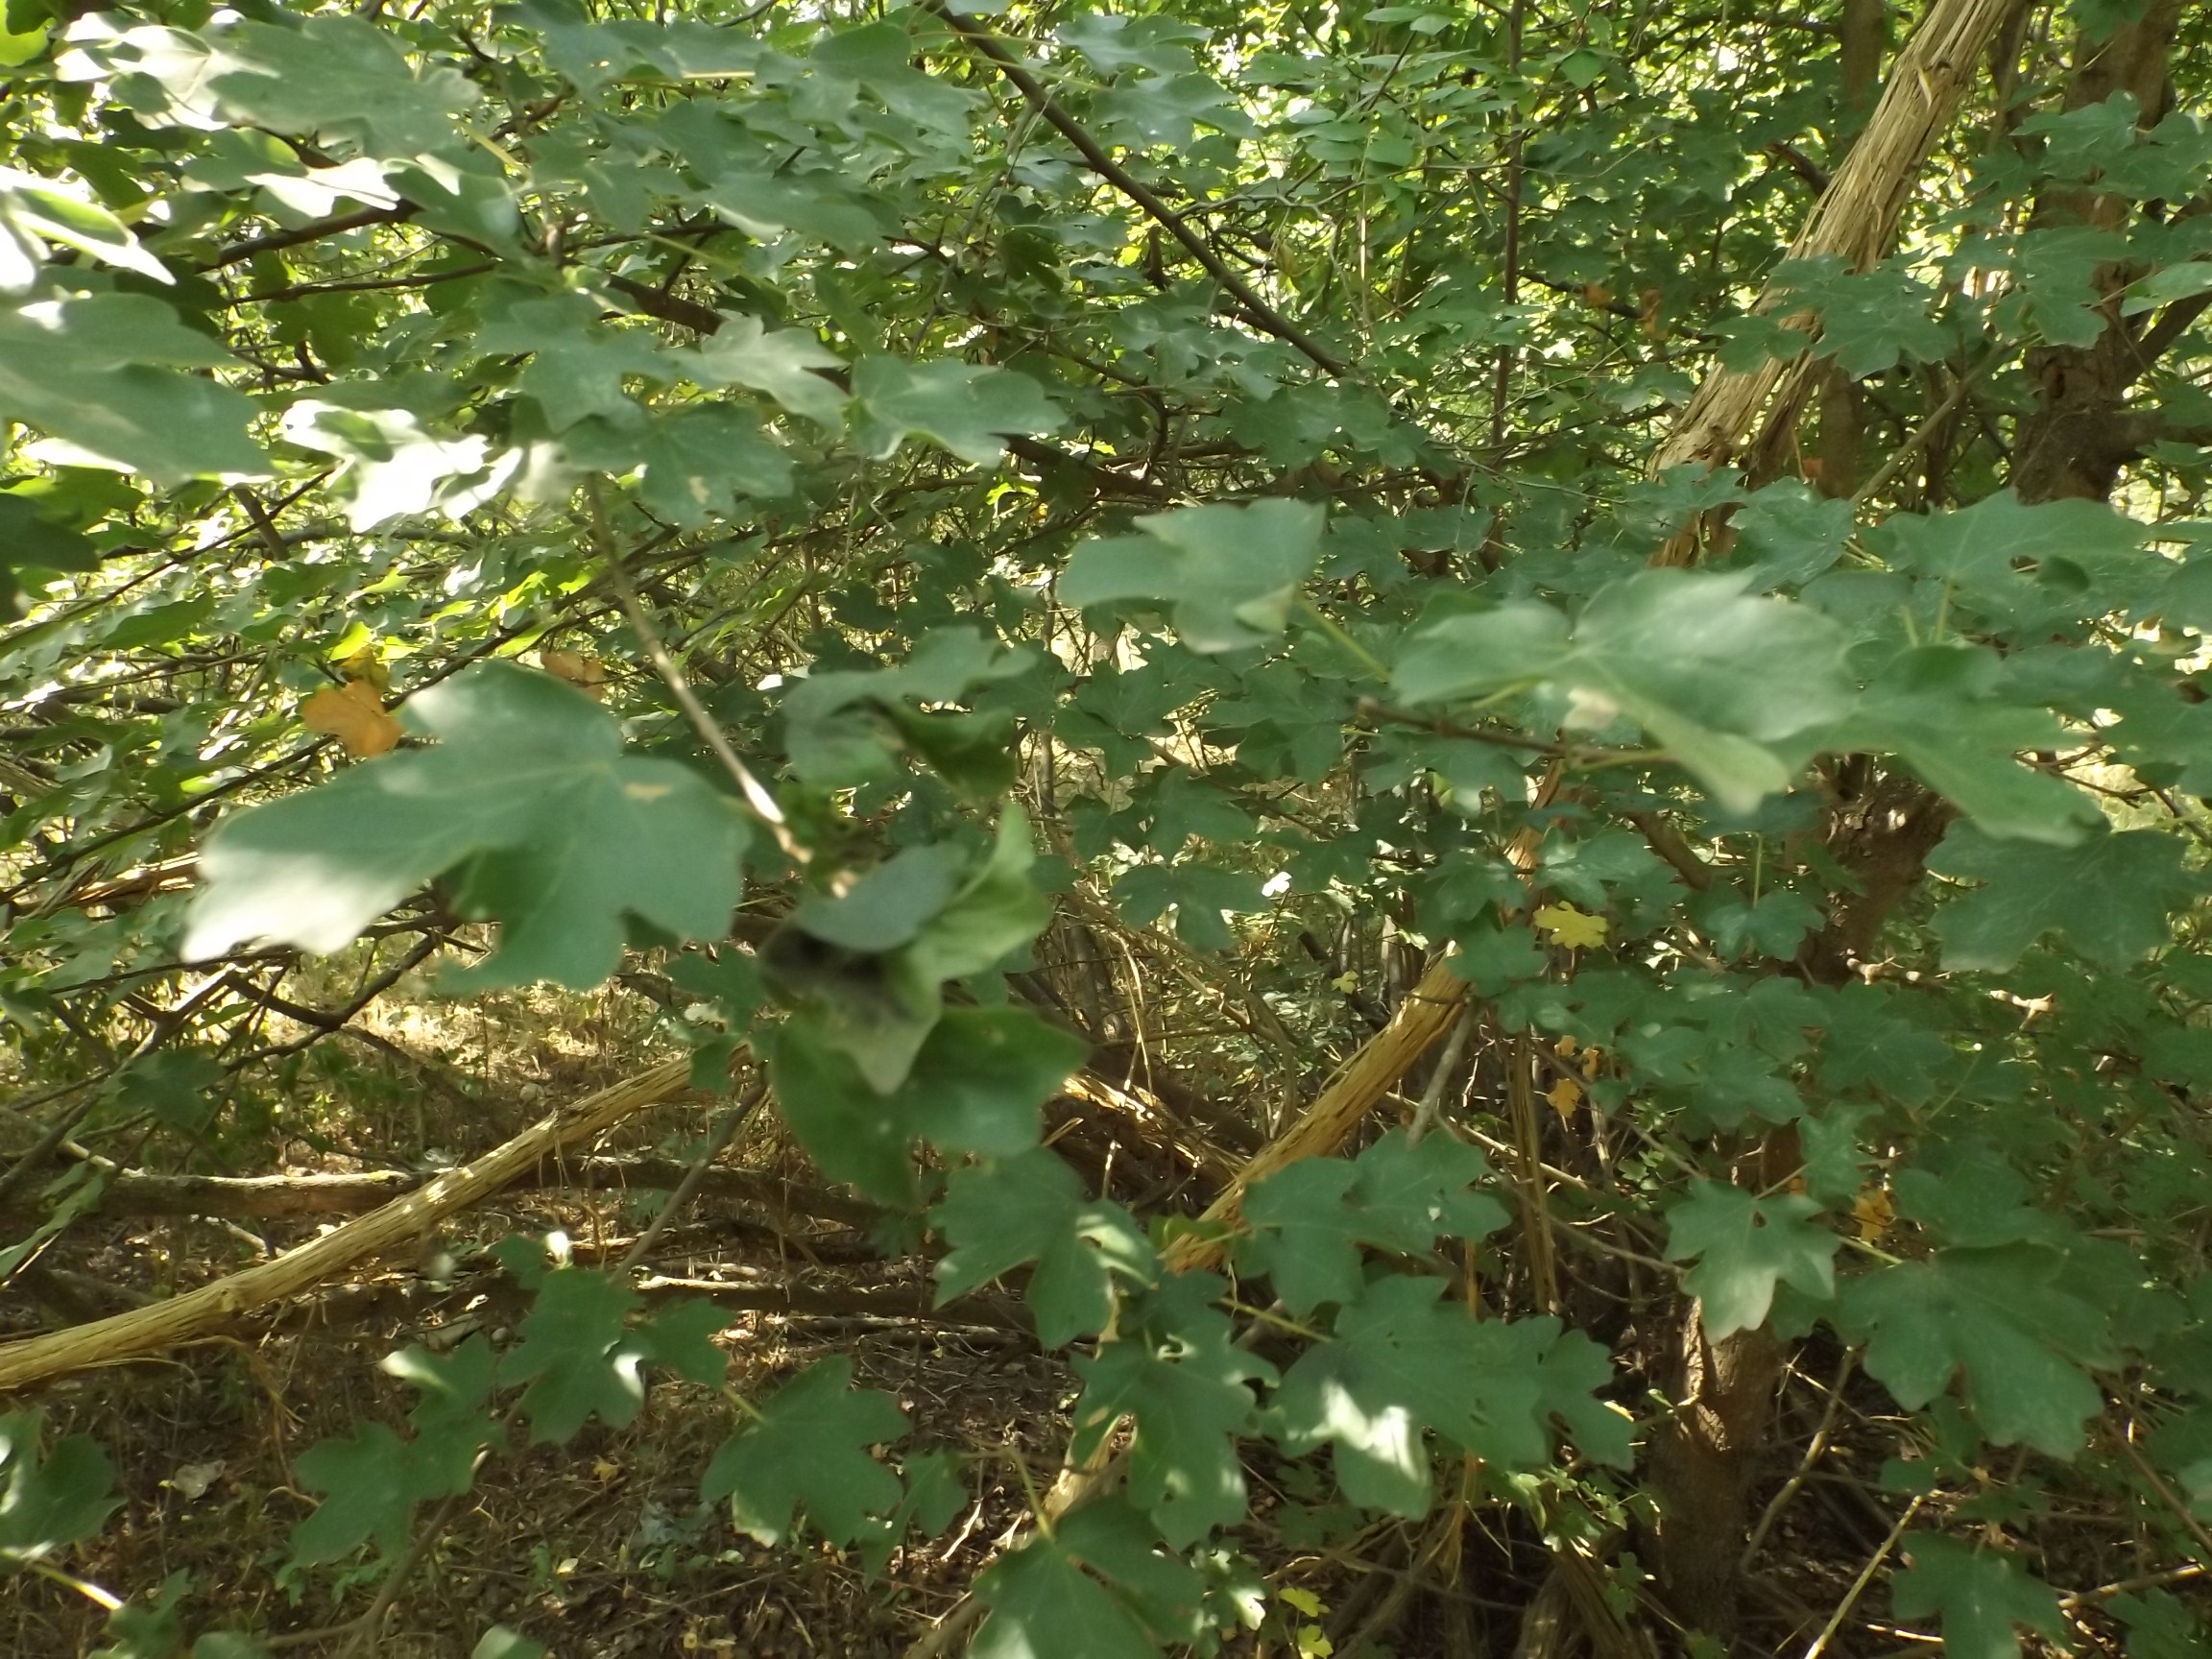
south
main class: Woodland
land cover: Broadleaved woodland
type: mesophytic deciduous forest
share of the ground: > 75 %
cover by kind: broadleaved forest trees 95 %, shrubs 5 %
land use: Forestry
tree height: > 5 m
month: August
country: BG
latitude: 43.2370
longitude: 27.7058
